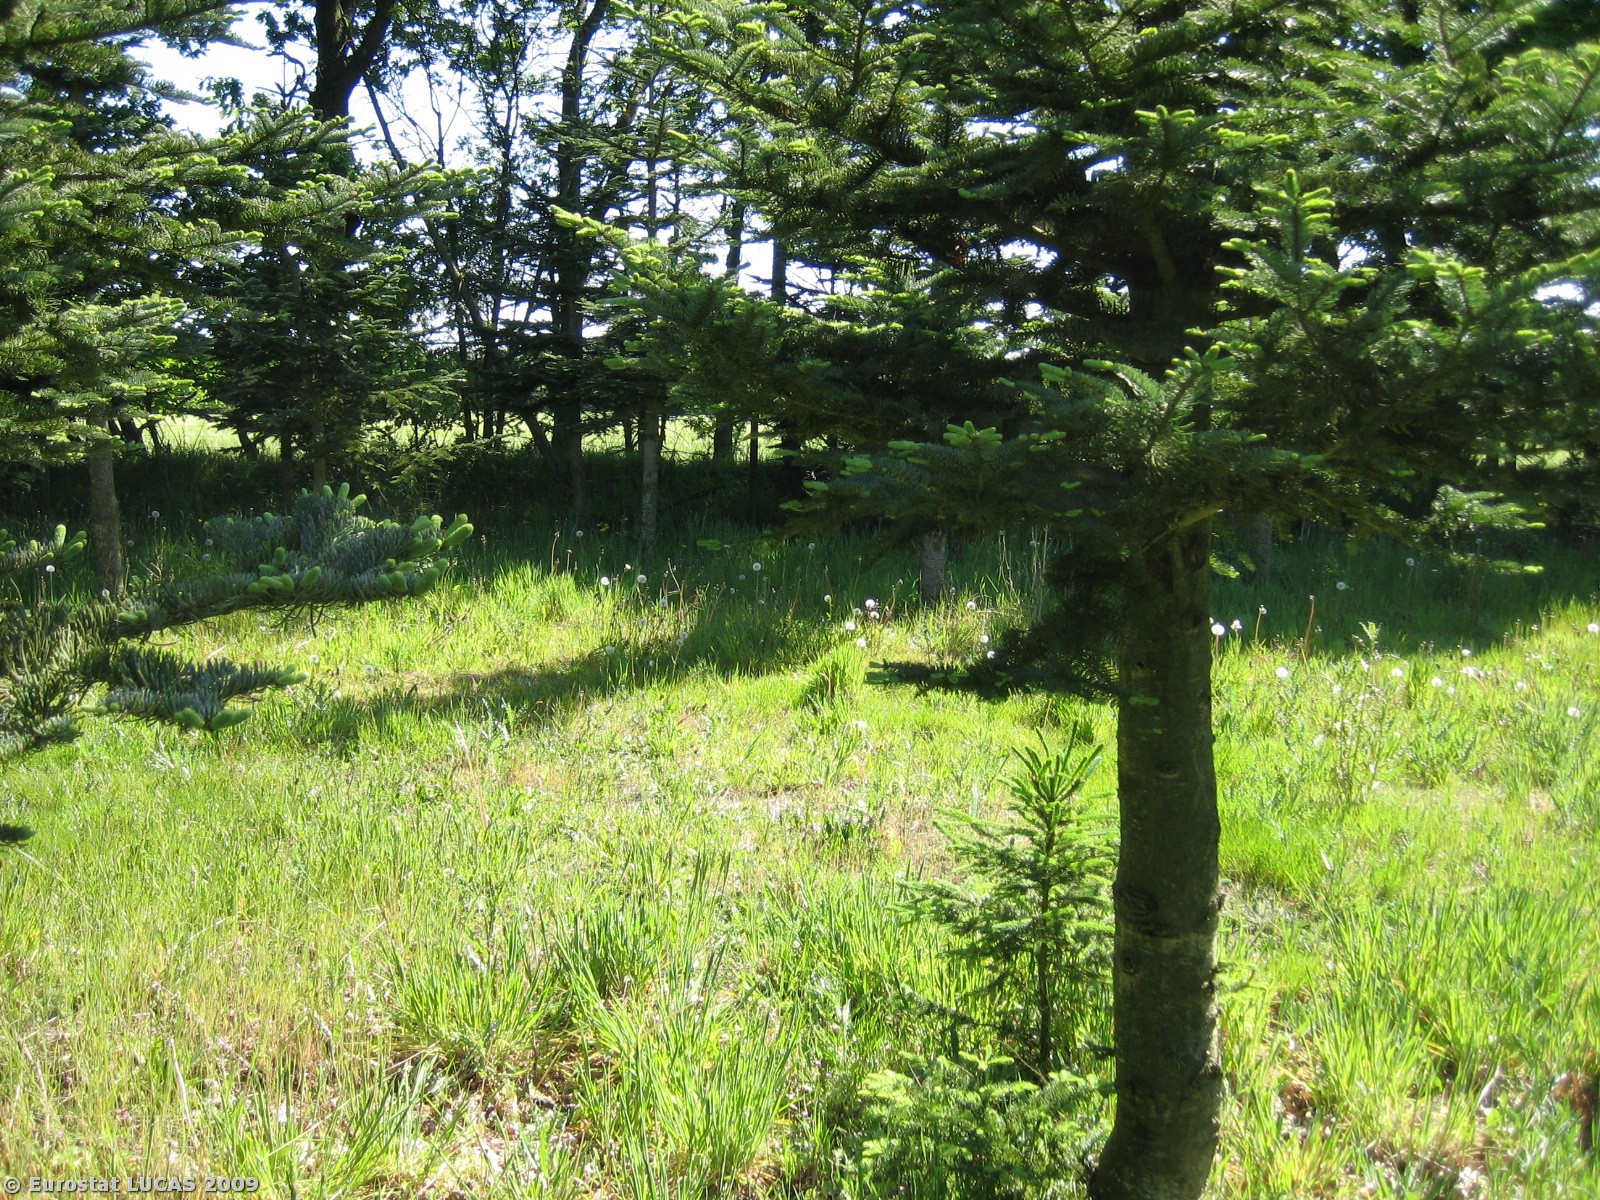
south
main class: Woodland
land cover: Coniferous woodland
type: hemiboreal forest and nemoral coniferous forest and mixed broadleaved-coniferous forest
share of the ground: 25 - 50 %
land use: Forestry
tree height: > 5 m
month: May
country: DK
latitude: 55.8782
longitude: 8.9940
